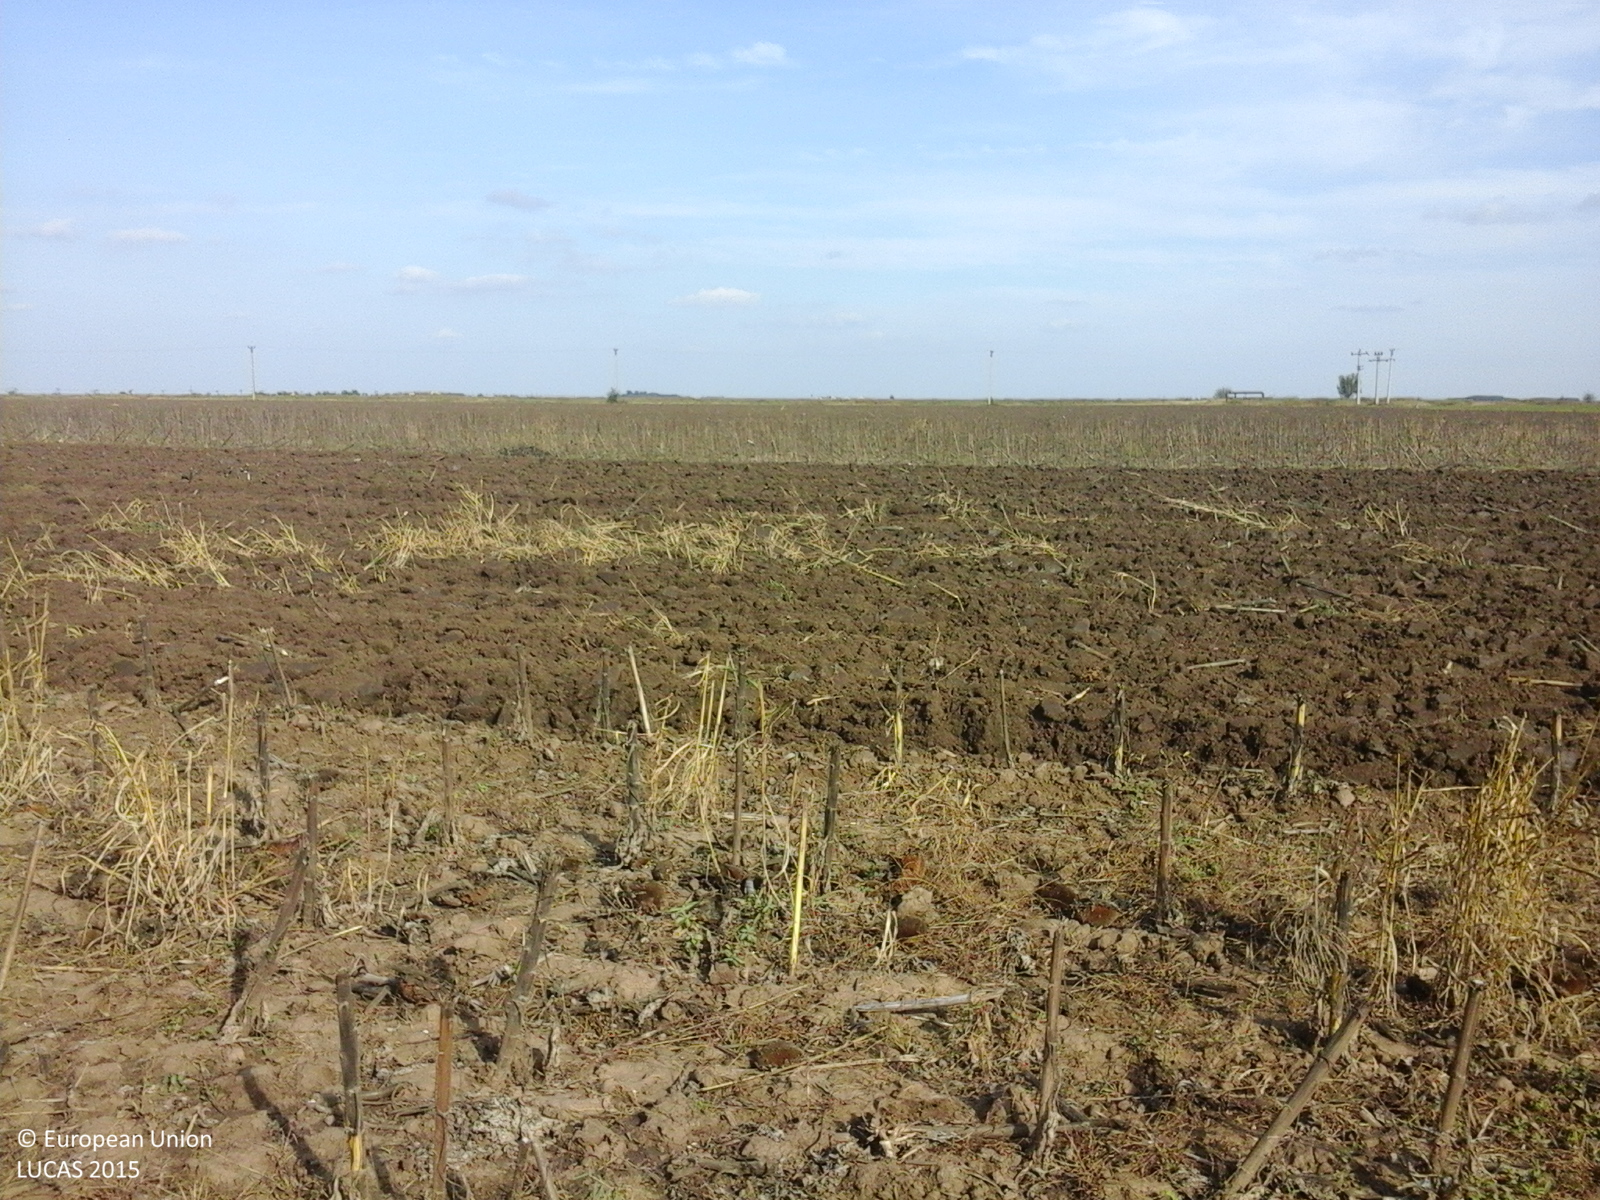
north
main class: Cropland
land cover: Sunflower
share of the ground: 10 - 25 %
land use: Agriculture (excluding fallow land and kitchen gardens)
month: October
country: RO
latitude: 45.1957
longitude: 27.2382
